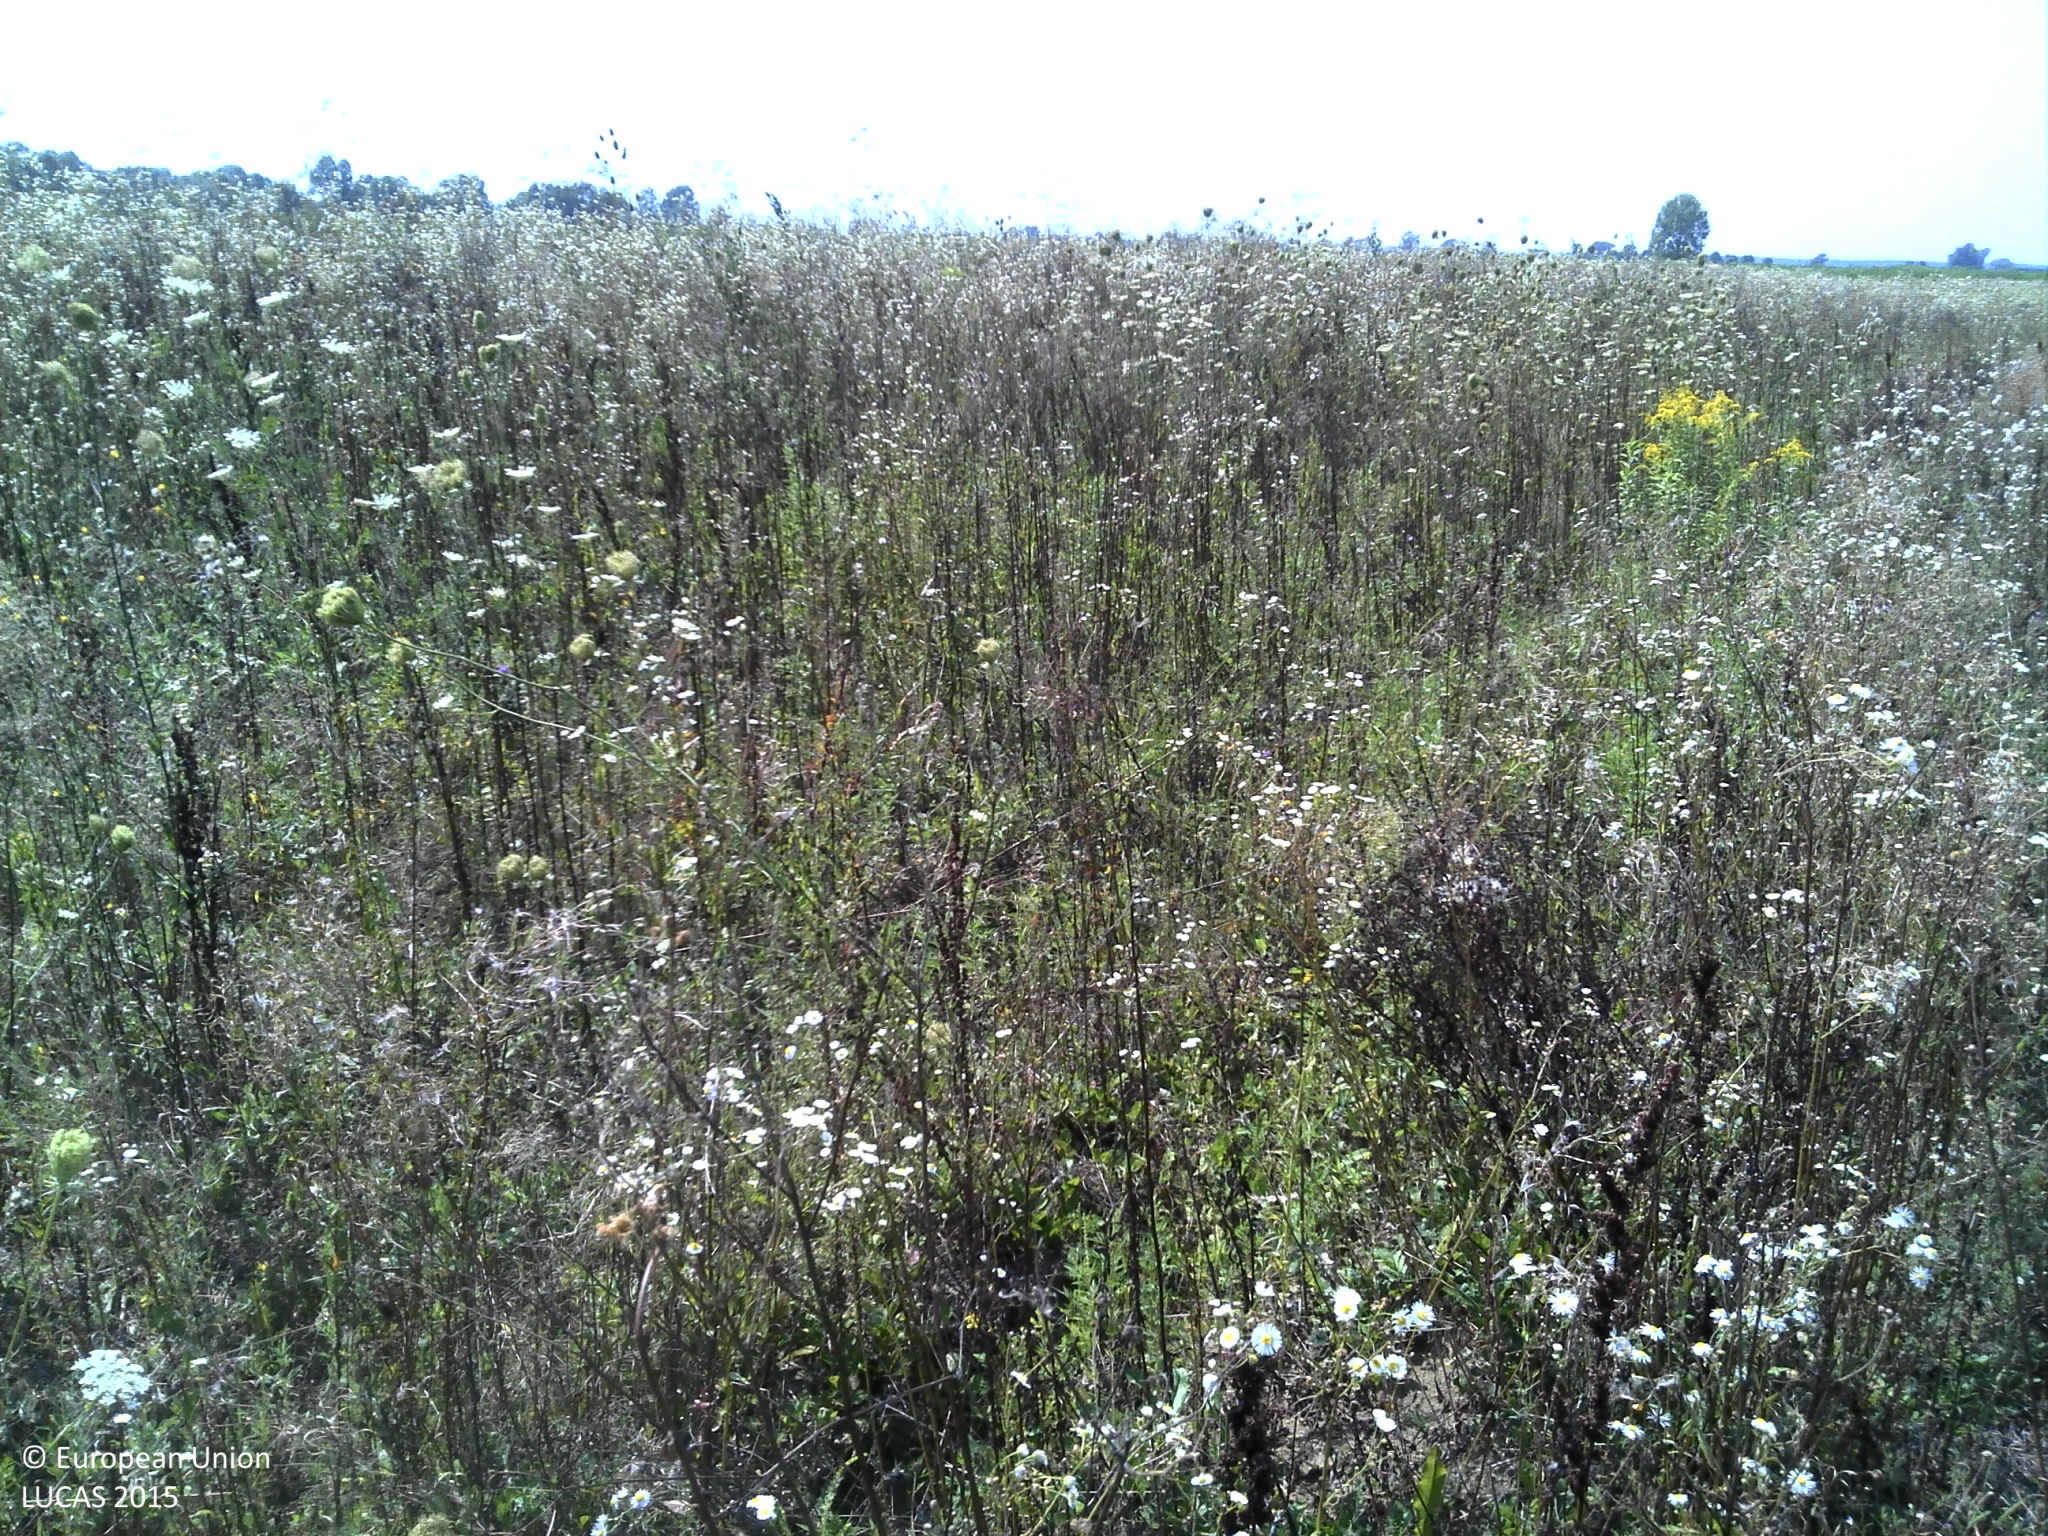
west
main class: Grassland
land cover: Spontaneously vegetated surfaces
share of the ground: > 75 %
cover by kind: herbaceous plants 100 %
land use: Fallow land
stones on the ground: < 10 %
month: August
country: HR
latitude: 45.2619
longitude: 17.1487
